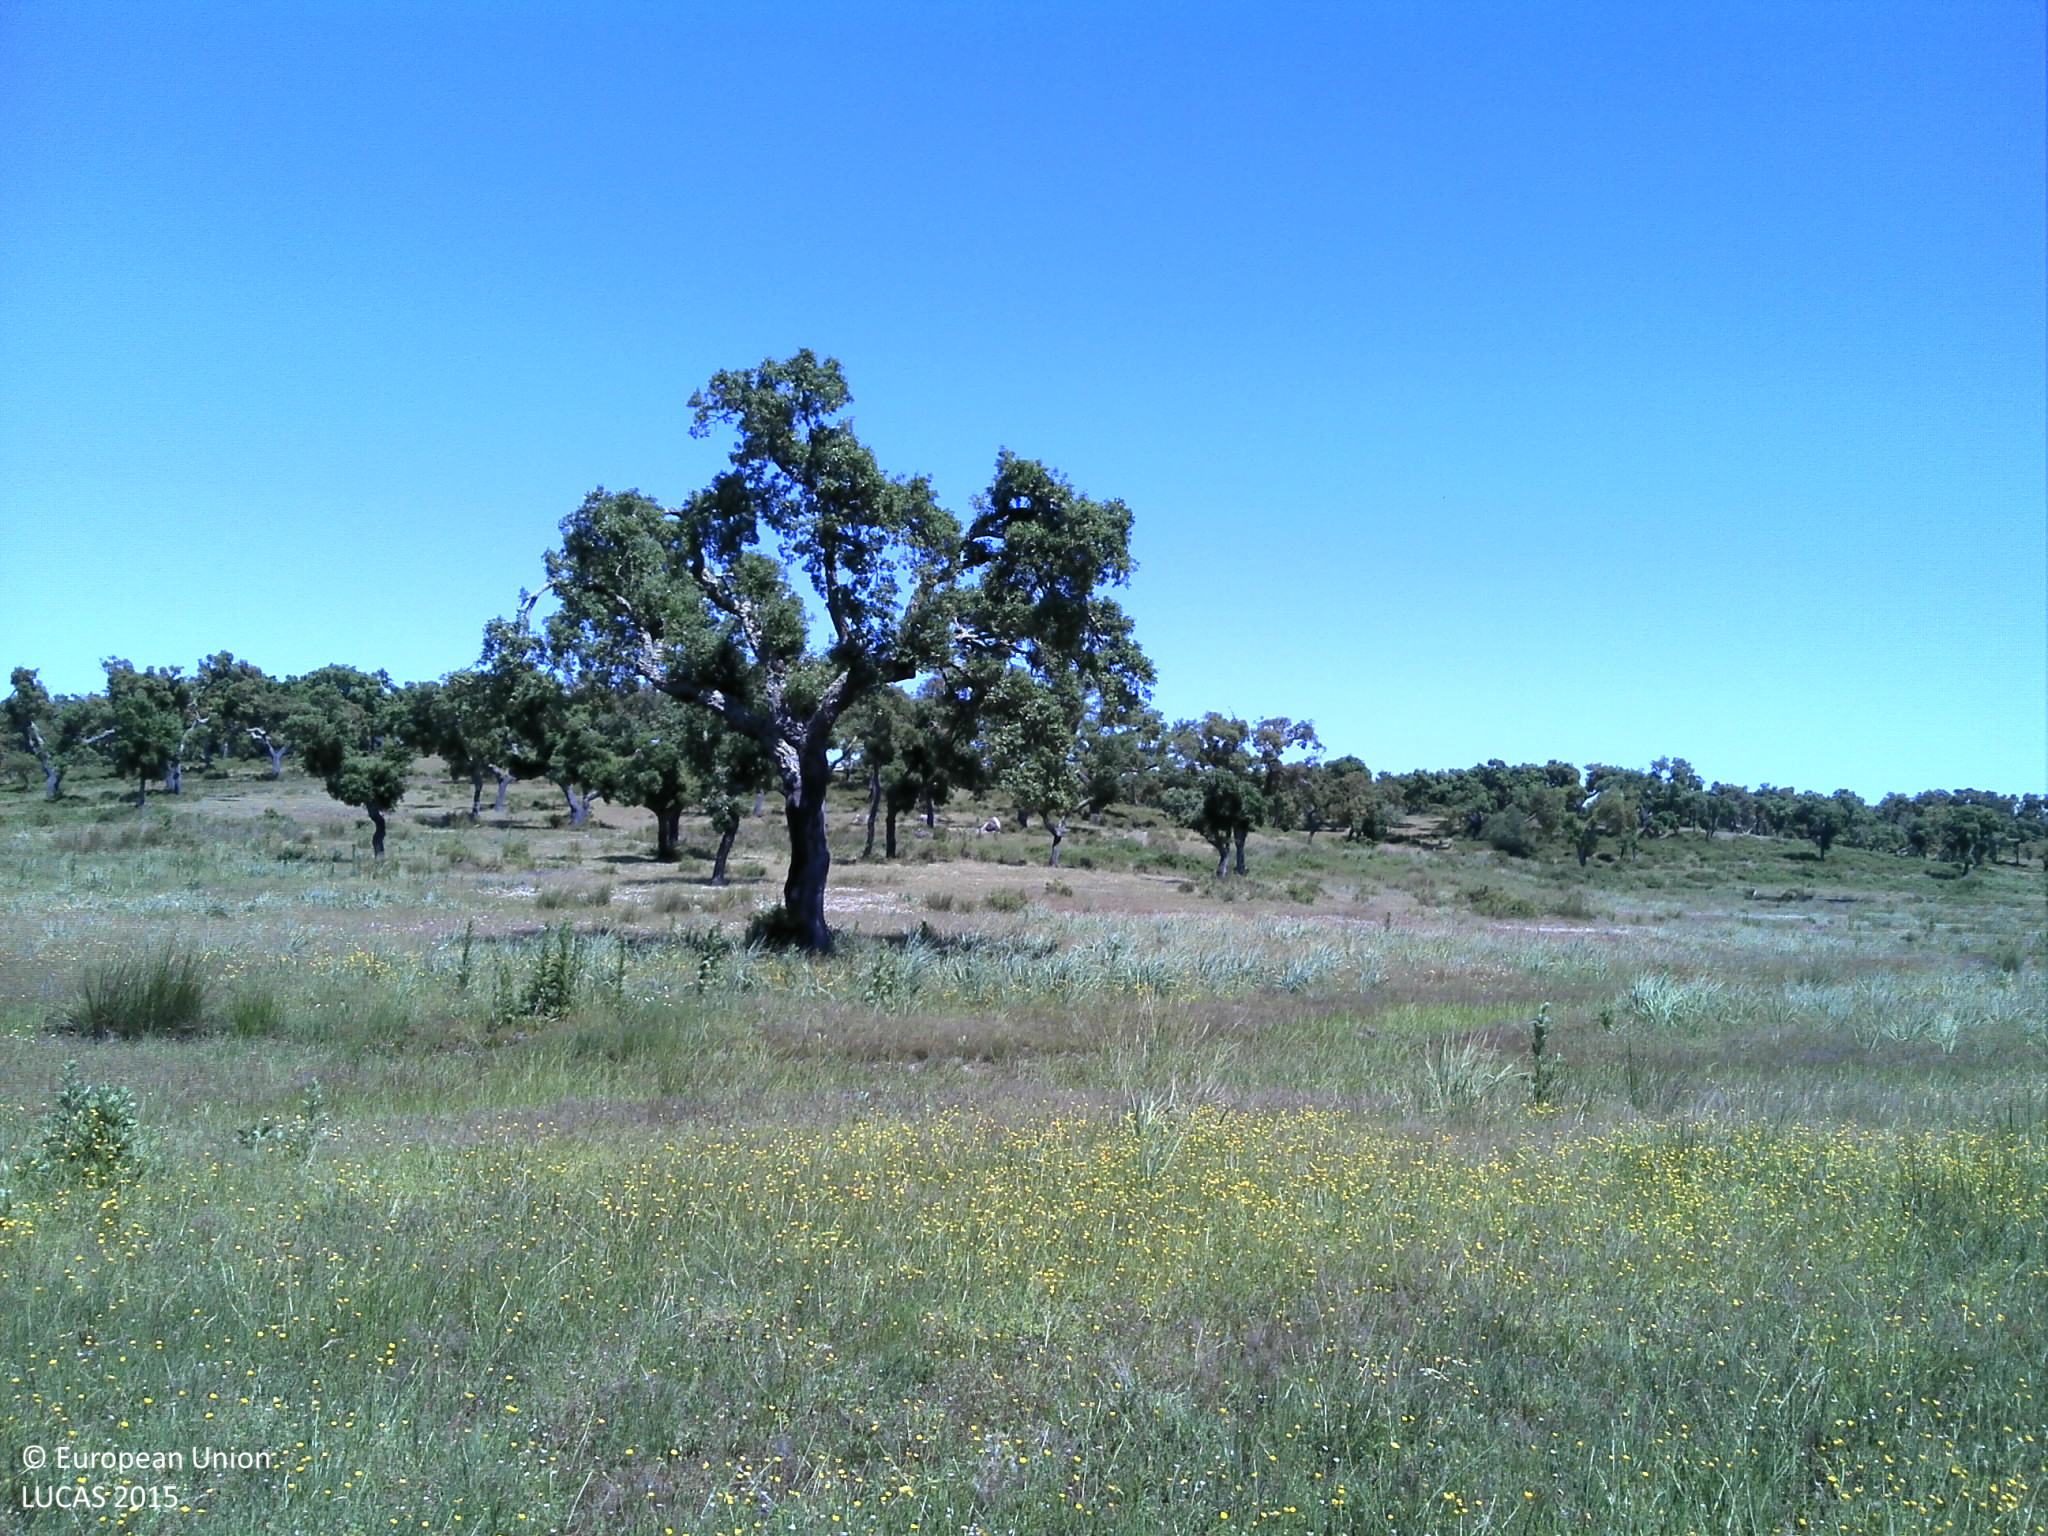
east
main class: Grassland
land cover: Grassland without tree/shrub cover
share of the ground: > 75 %
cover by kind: herbaceous plants 90 %, unconsolidated bare surface 10 %
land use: Agriculture (excluding fallow land and kitchen gardens)
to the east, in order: Grassland without tree/shrub cover; Broadleaved woodland; Tracks; Broadleaved woodland
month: May
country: PT
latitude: 39.1723
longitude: -7.9346
